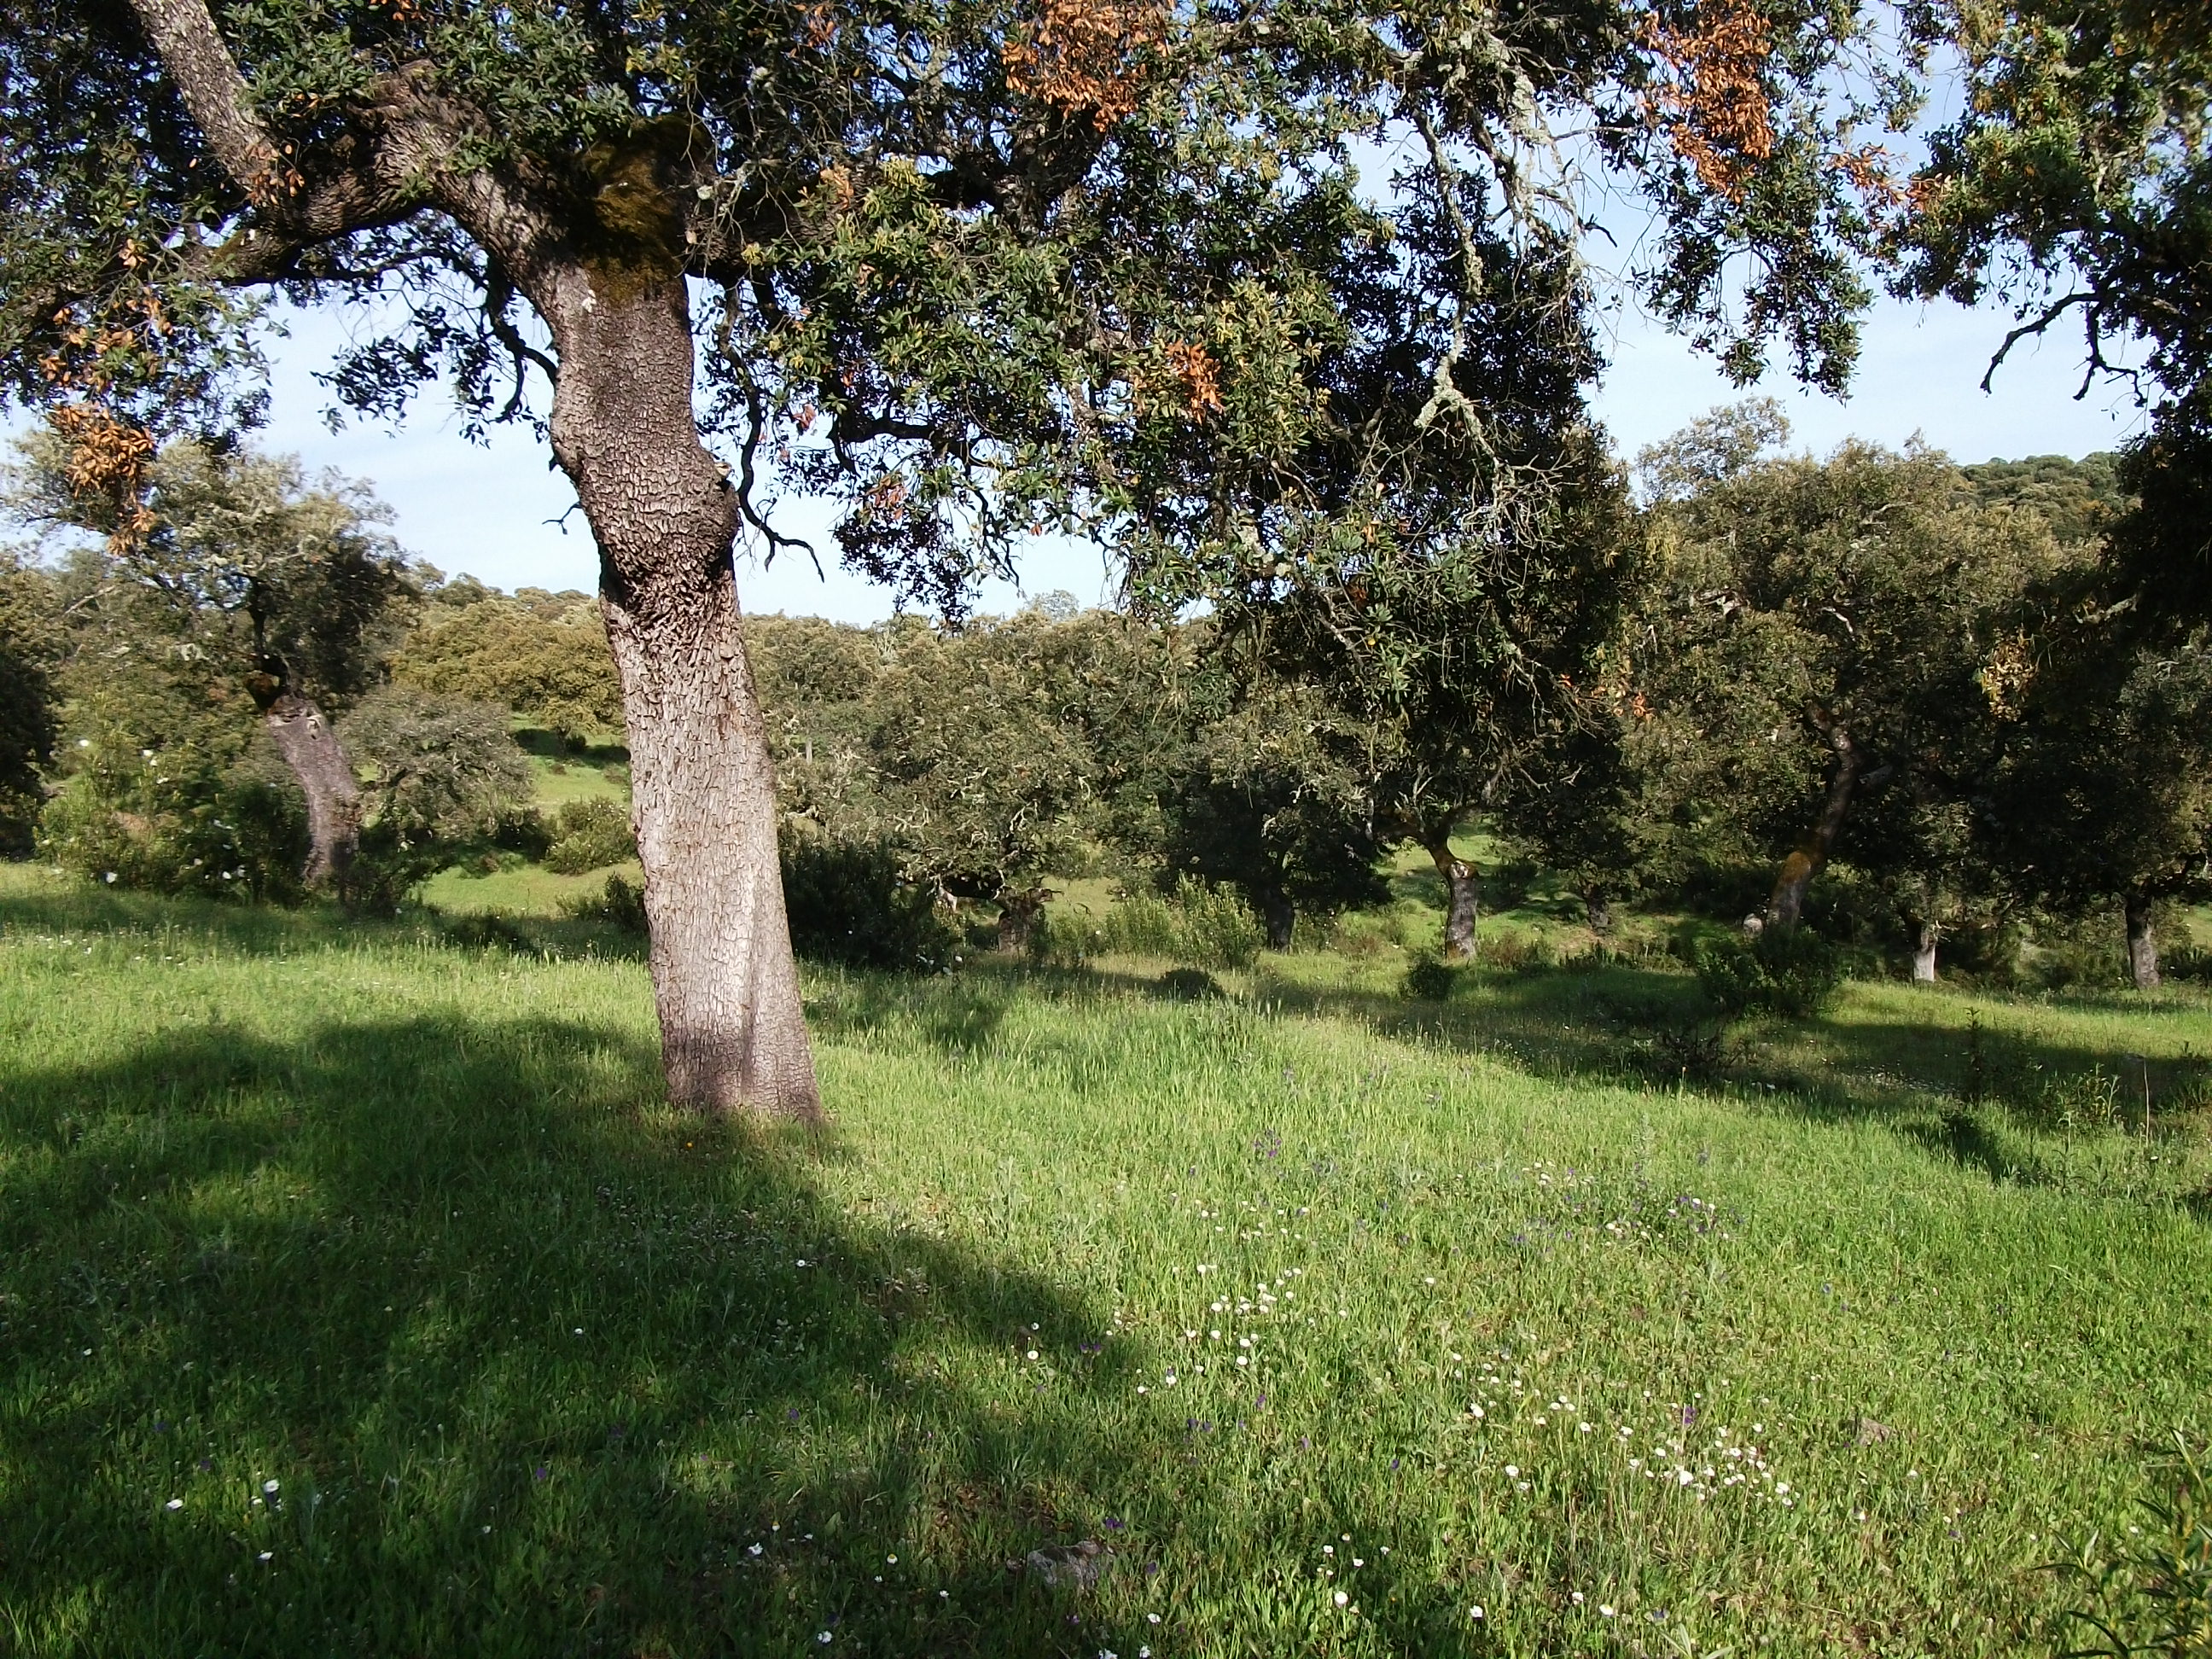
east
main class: Woodland
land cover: Broadleaved woodland
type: broadleaved evergreen forest
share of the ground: 25 - 50 %
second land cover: Spontaneously vegetated surfaces
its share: 50 - 75 %
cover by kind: herbaceous plants 50 %, broadleaved forest trees 40 %, shrubs 10 %
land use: Forestry
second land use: Agriculture (excluding fallow land and kitchen gardens)
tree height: > 5 m
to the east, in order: Broadleaved woodland; Spontaneously vegetated surfaces; Rivers and streams; Broadleaved woodland
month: April
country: ES
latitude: 38.0936
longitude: -6.6625
